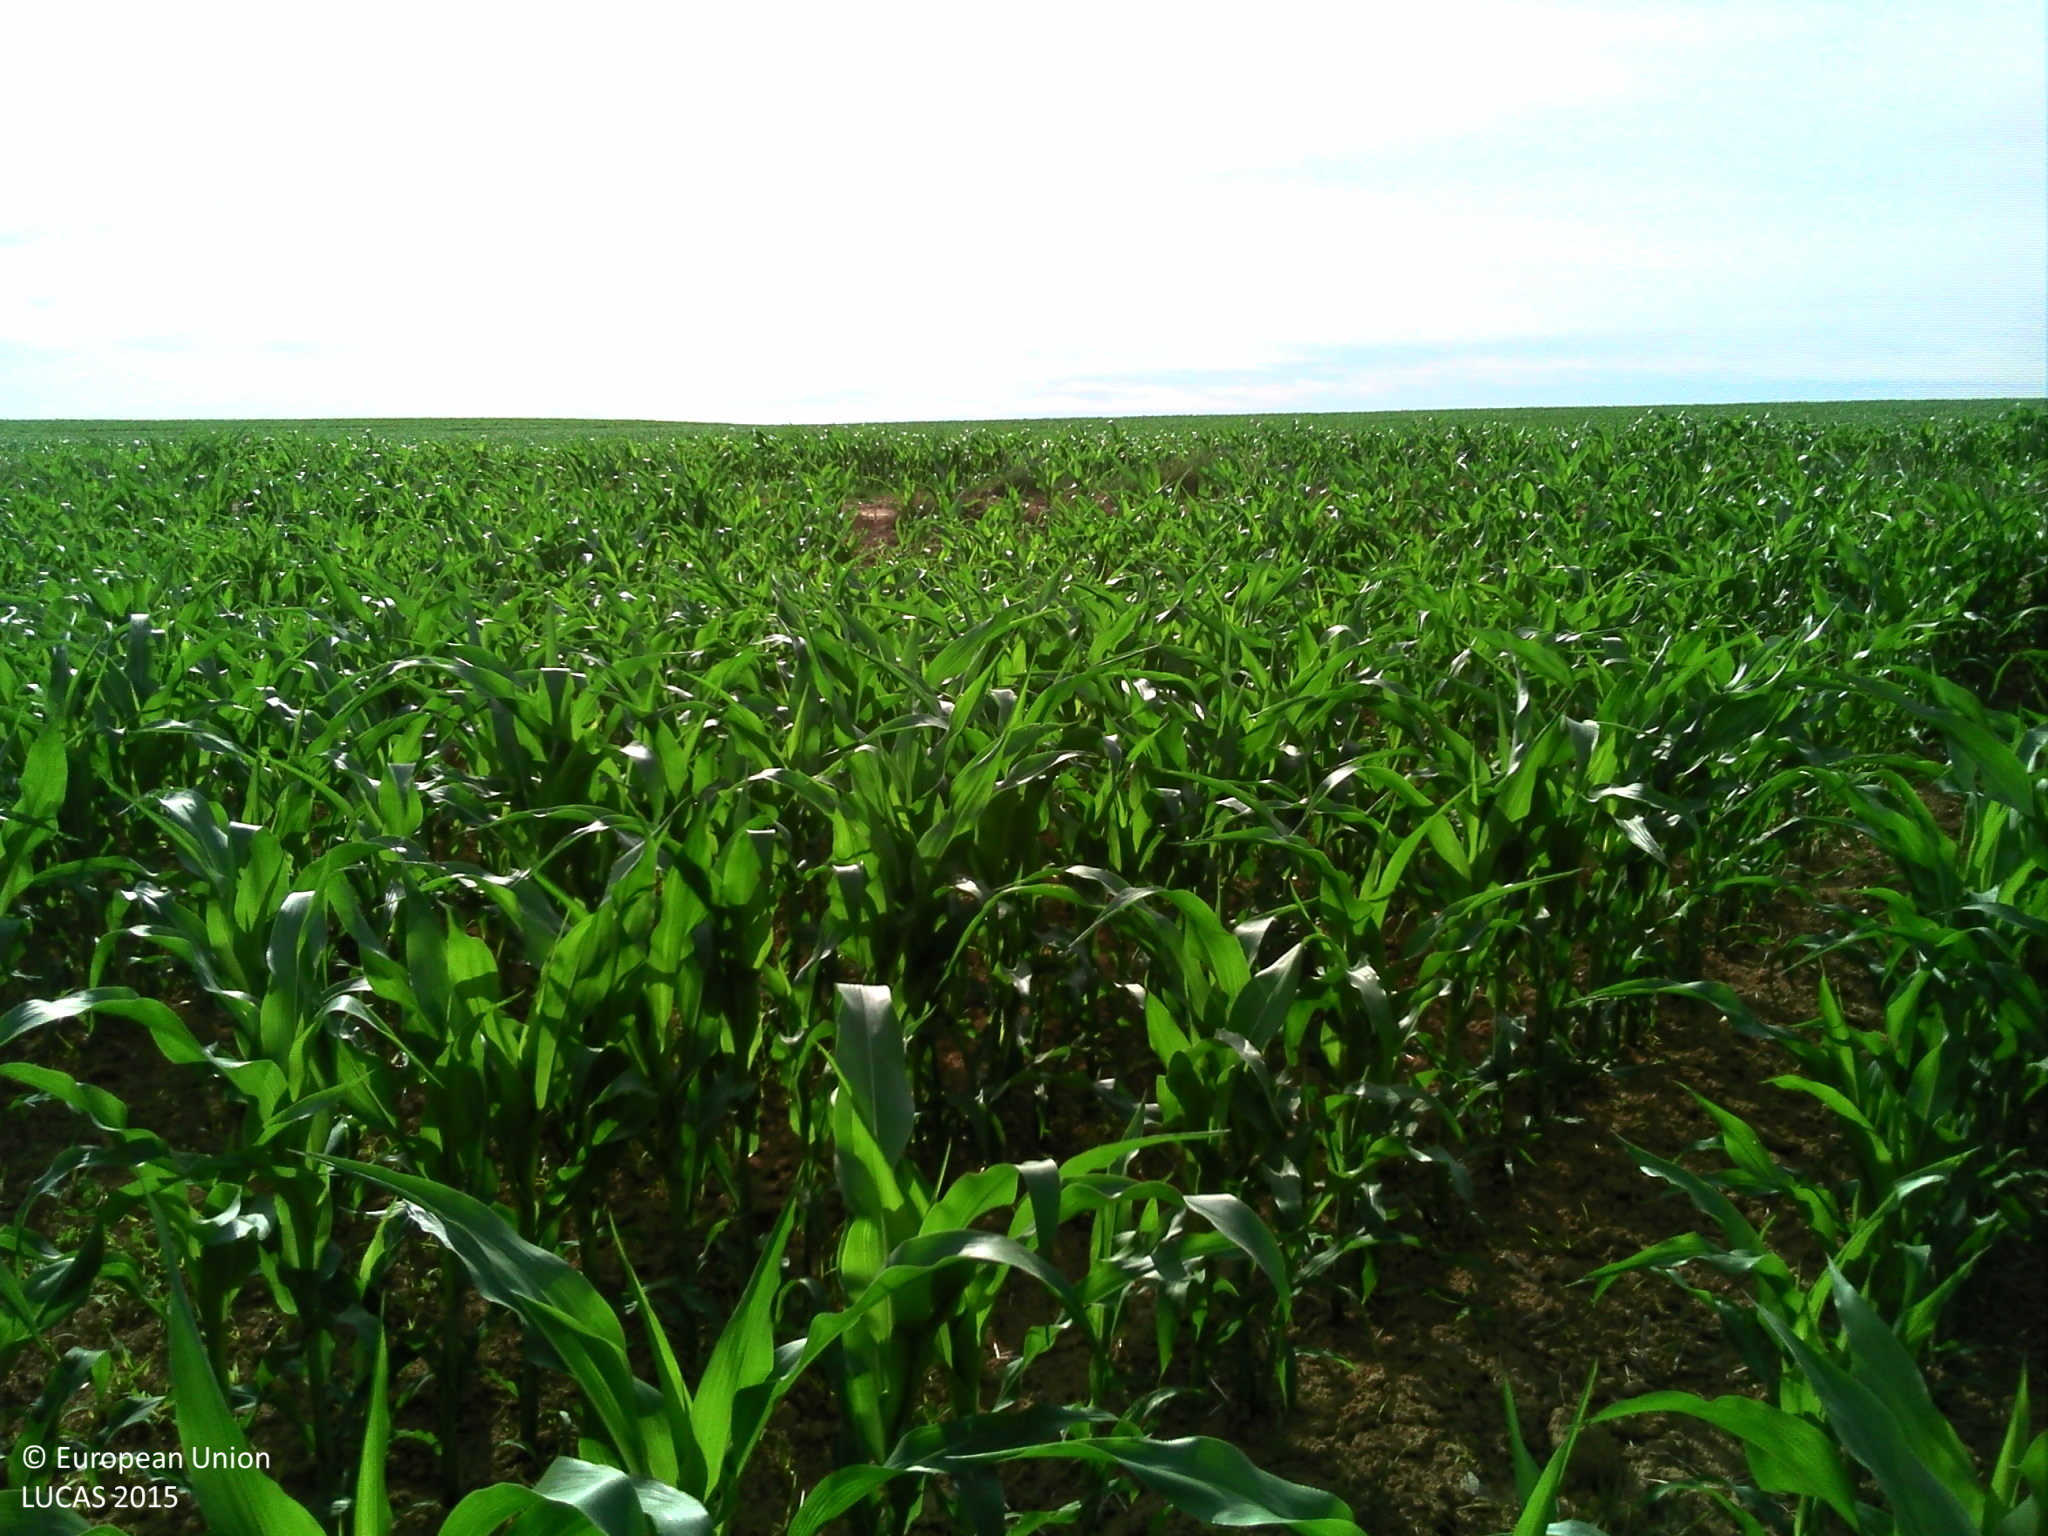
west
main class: Cropland
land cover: Maize
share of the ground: > 75 %
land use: Agriculture (excluding fallow land and kitchen gardens)
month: June
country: FR
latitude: 48.7733
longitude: 7.5923
